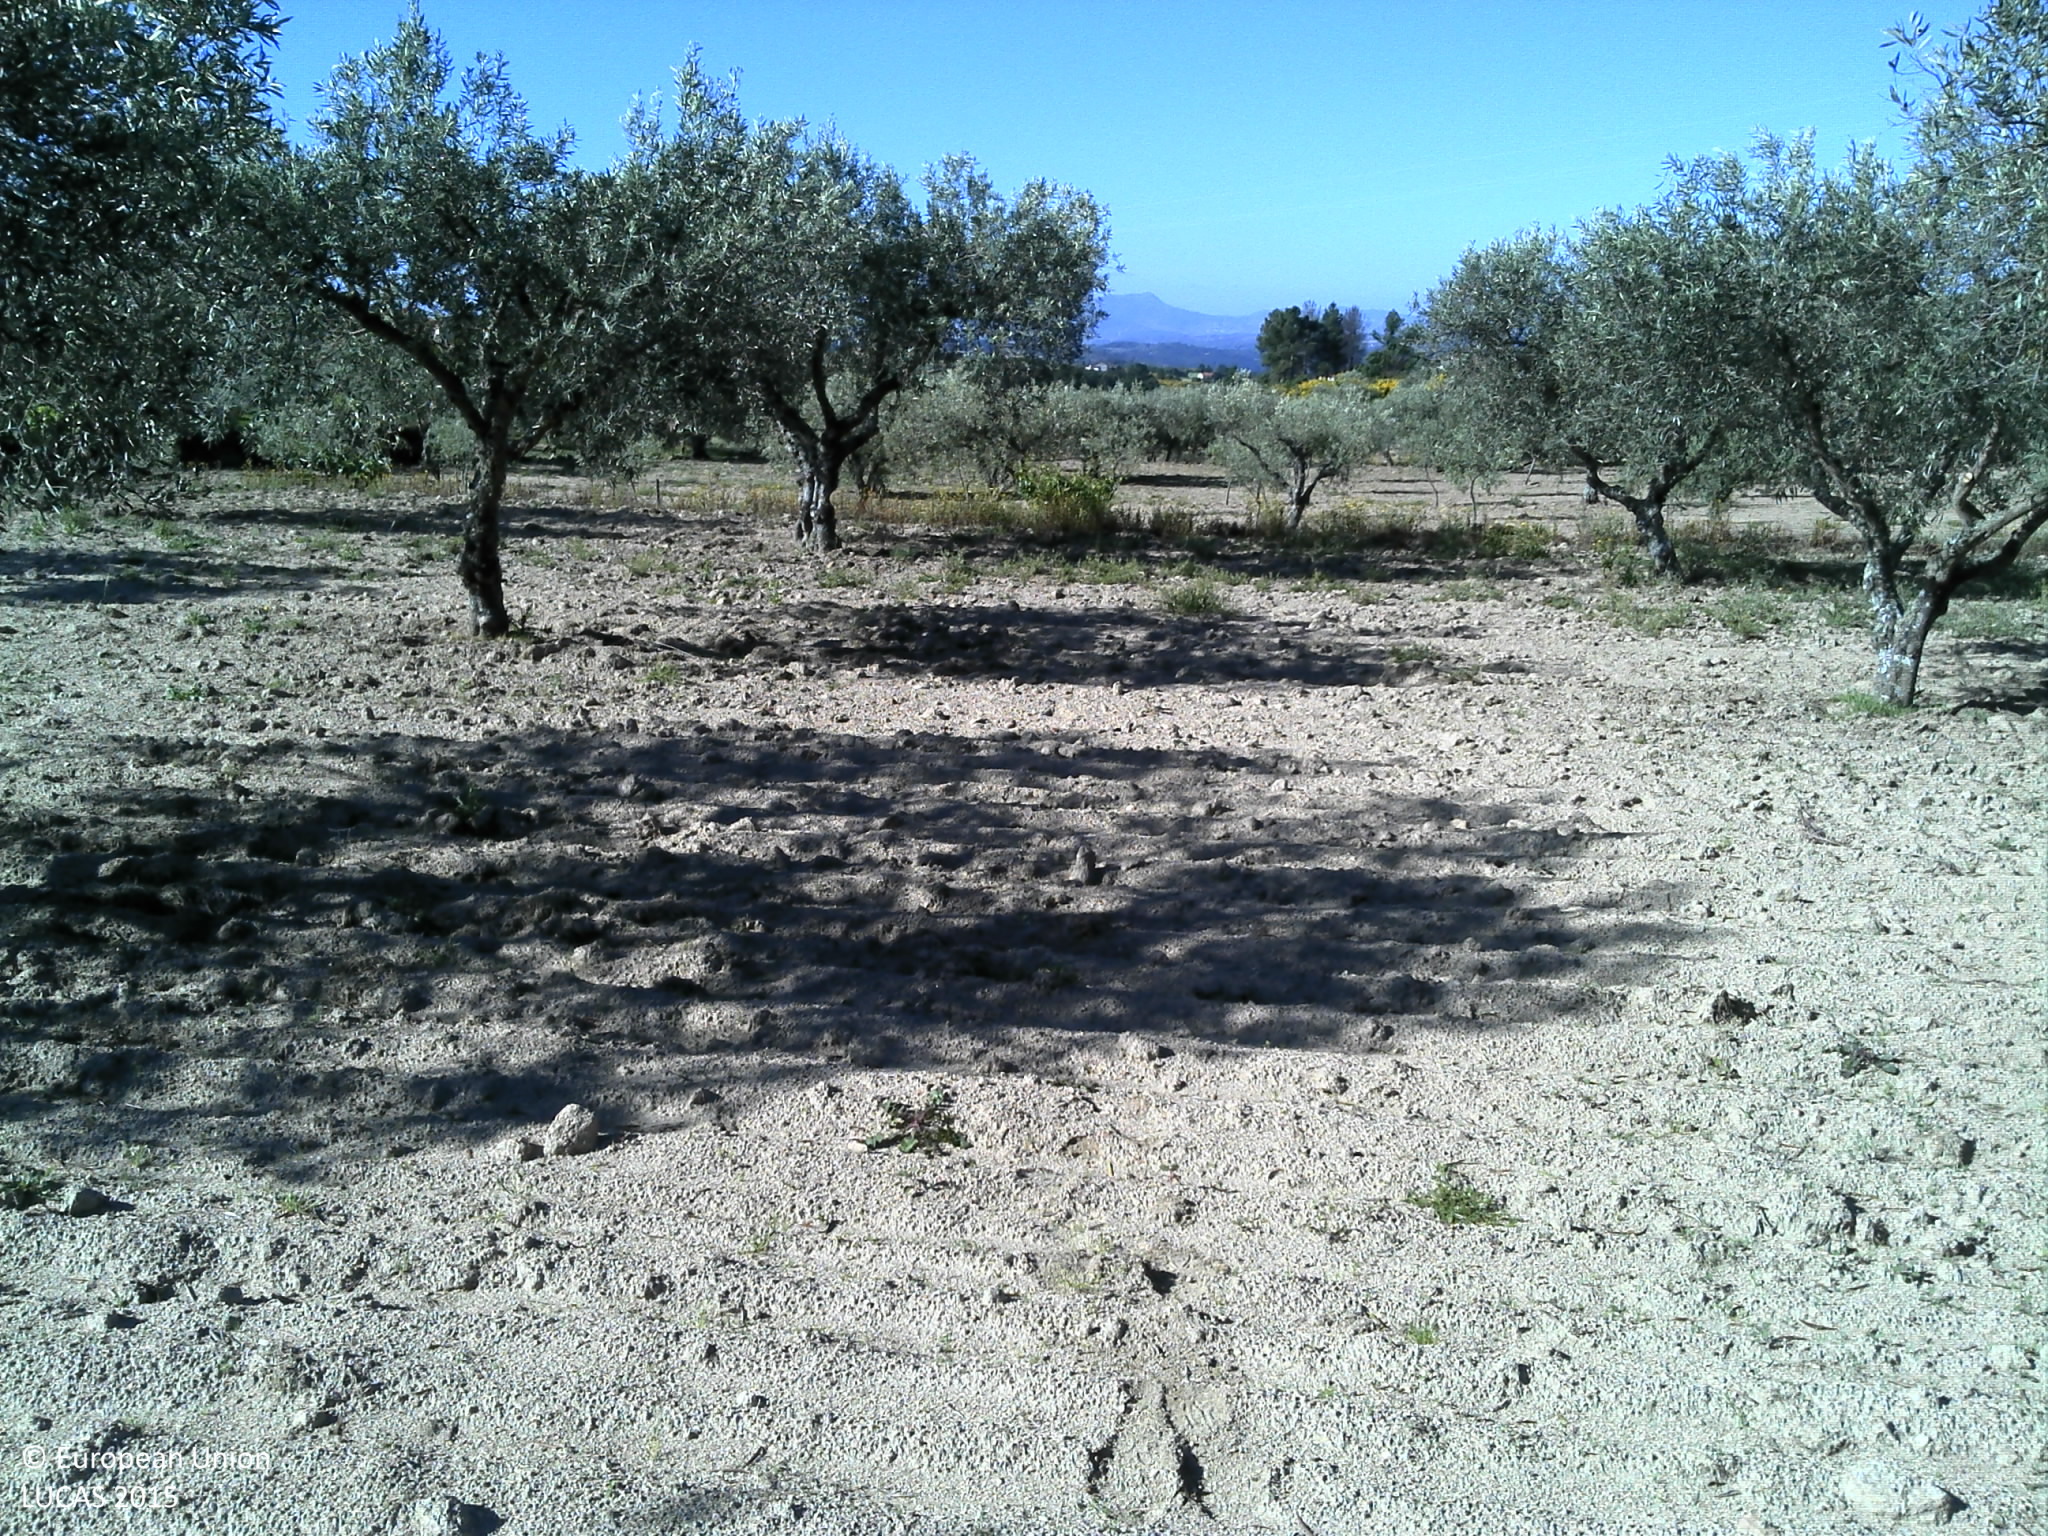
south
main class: Cropland
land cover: Olive groves
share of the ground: 25 - 50 %
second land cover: Other bare soil
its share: > 75 %
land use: Agriculture (excluding fallow land and kitchen gardens)
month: May
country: PT
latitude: 41.7257
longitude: -7.1807
